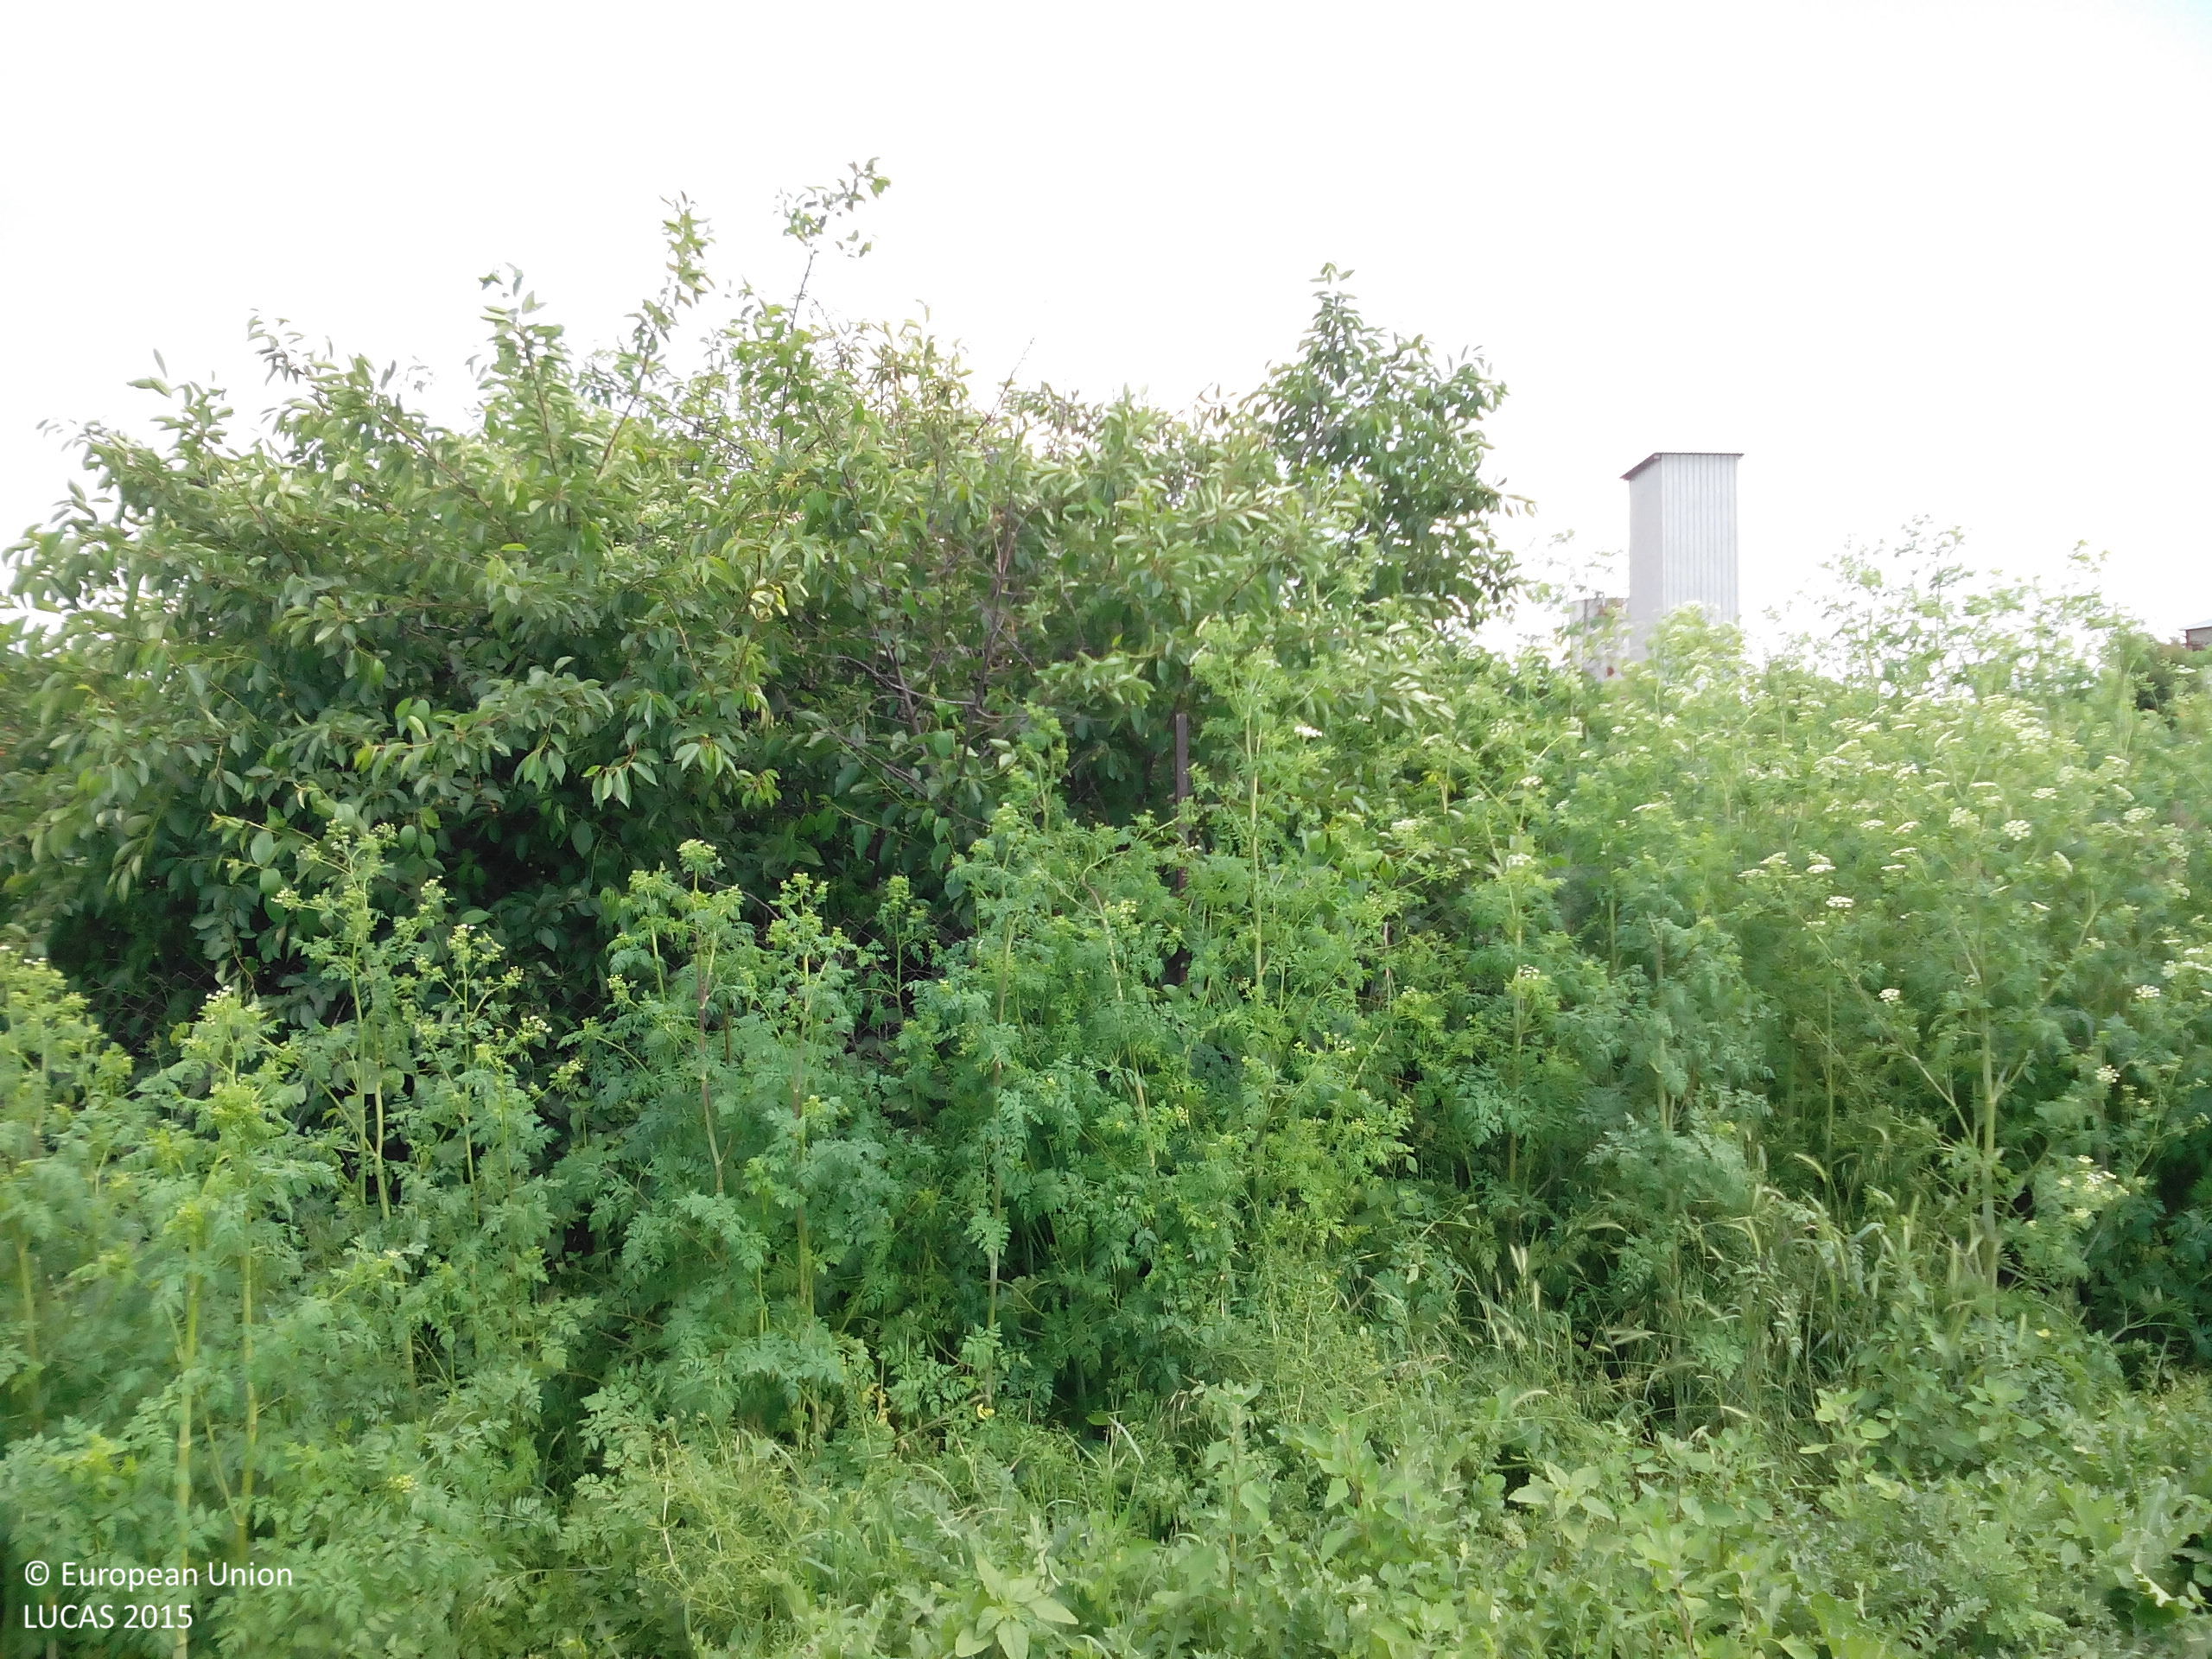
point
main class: Cropland
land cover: Cherry fruit
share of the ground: > 75 %
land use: Kitchen garden
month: May
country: BG
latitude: 43.5058
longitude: 23.8664
